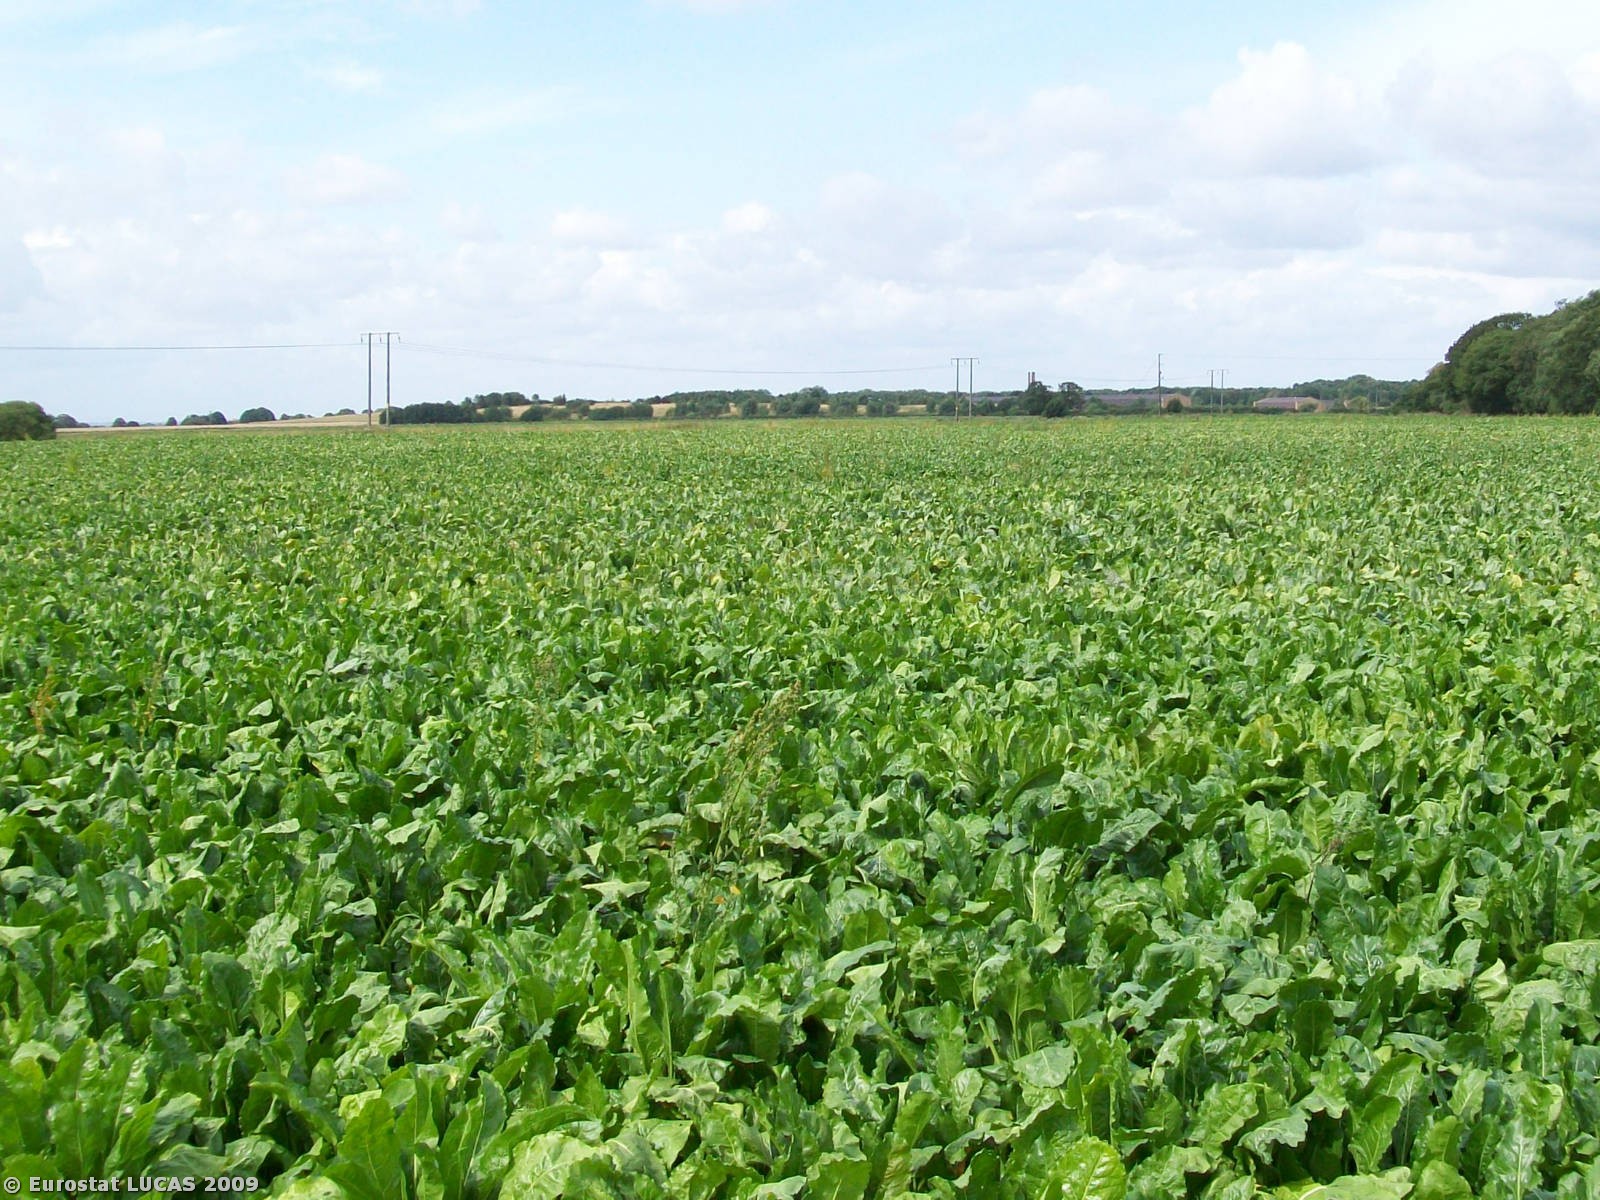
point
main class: Cropland
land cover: Sugar beet
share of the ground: > 75 %
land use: Agriculture (excluding fallow land and kitchen gardens)
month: August
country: GB
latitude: 53.8225
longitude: -1.0264
